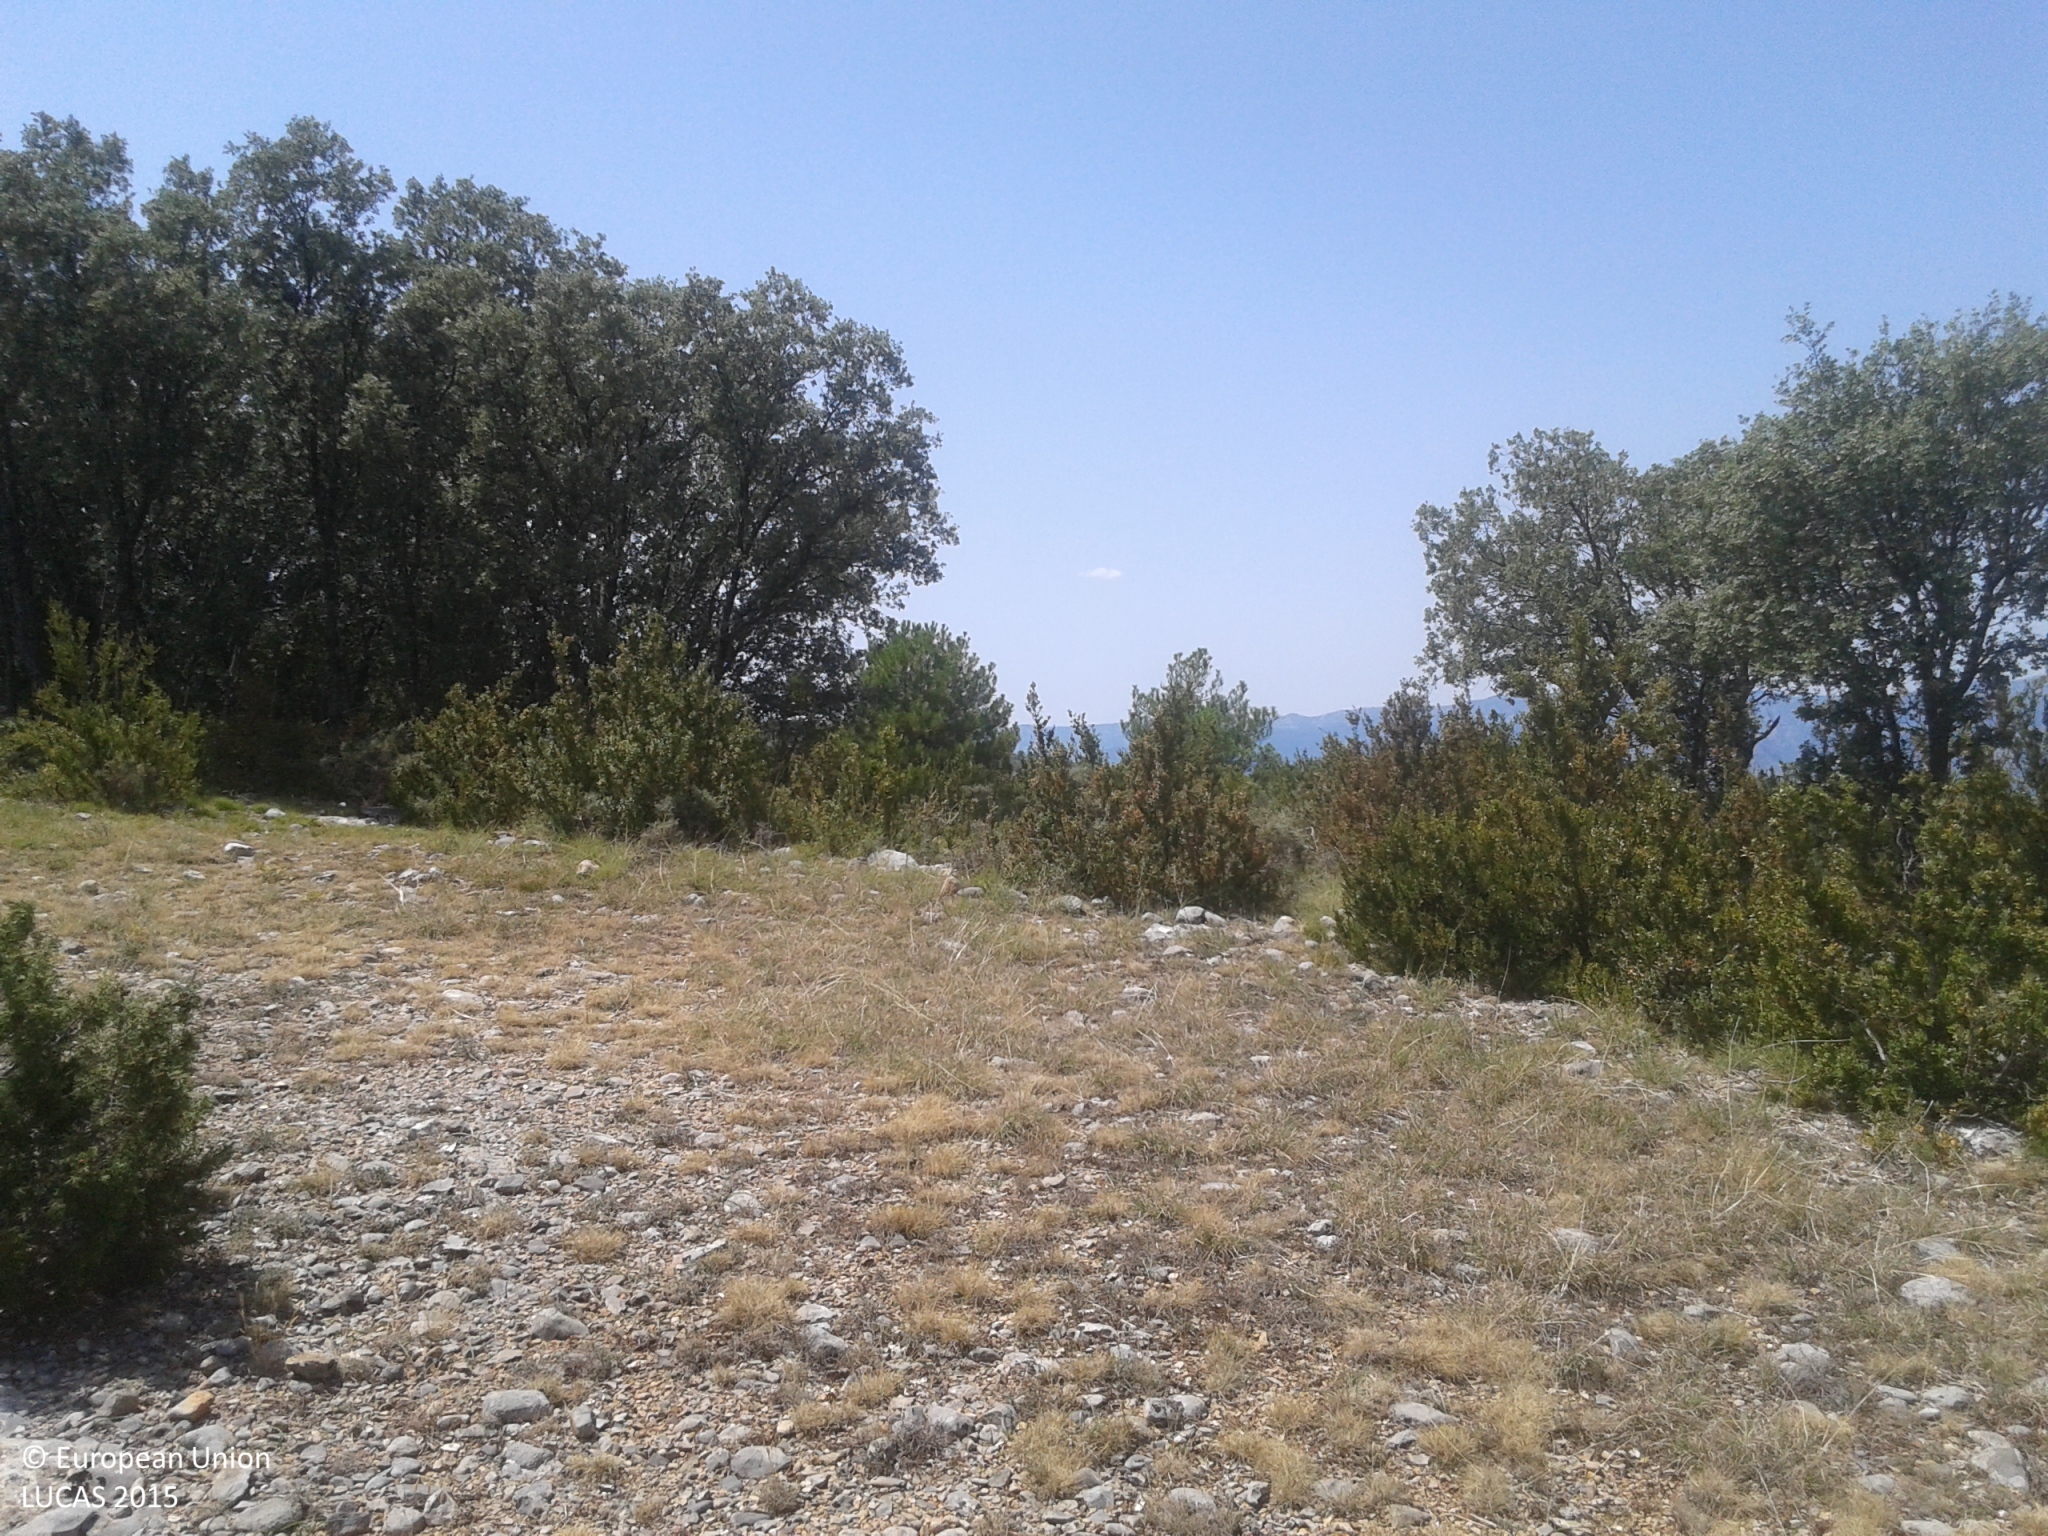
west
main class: Shrubland
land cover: Shrubland with sparse tree cover
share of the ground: 25 - 50 %
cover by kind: consolidated bare surface 35 %, shrubs 30 %, herbaceous plants 30 %, broadleaved forest trees 5 %
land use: Semi-natural and natural areas not in use
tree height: < 5 m
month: August
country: ES
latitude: 42.2235
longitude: 1.0804
